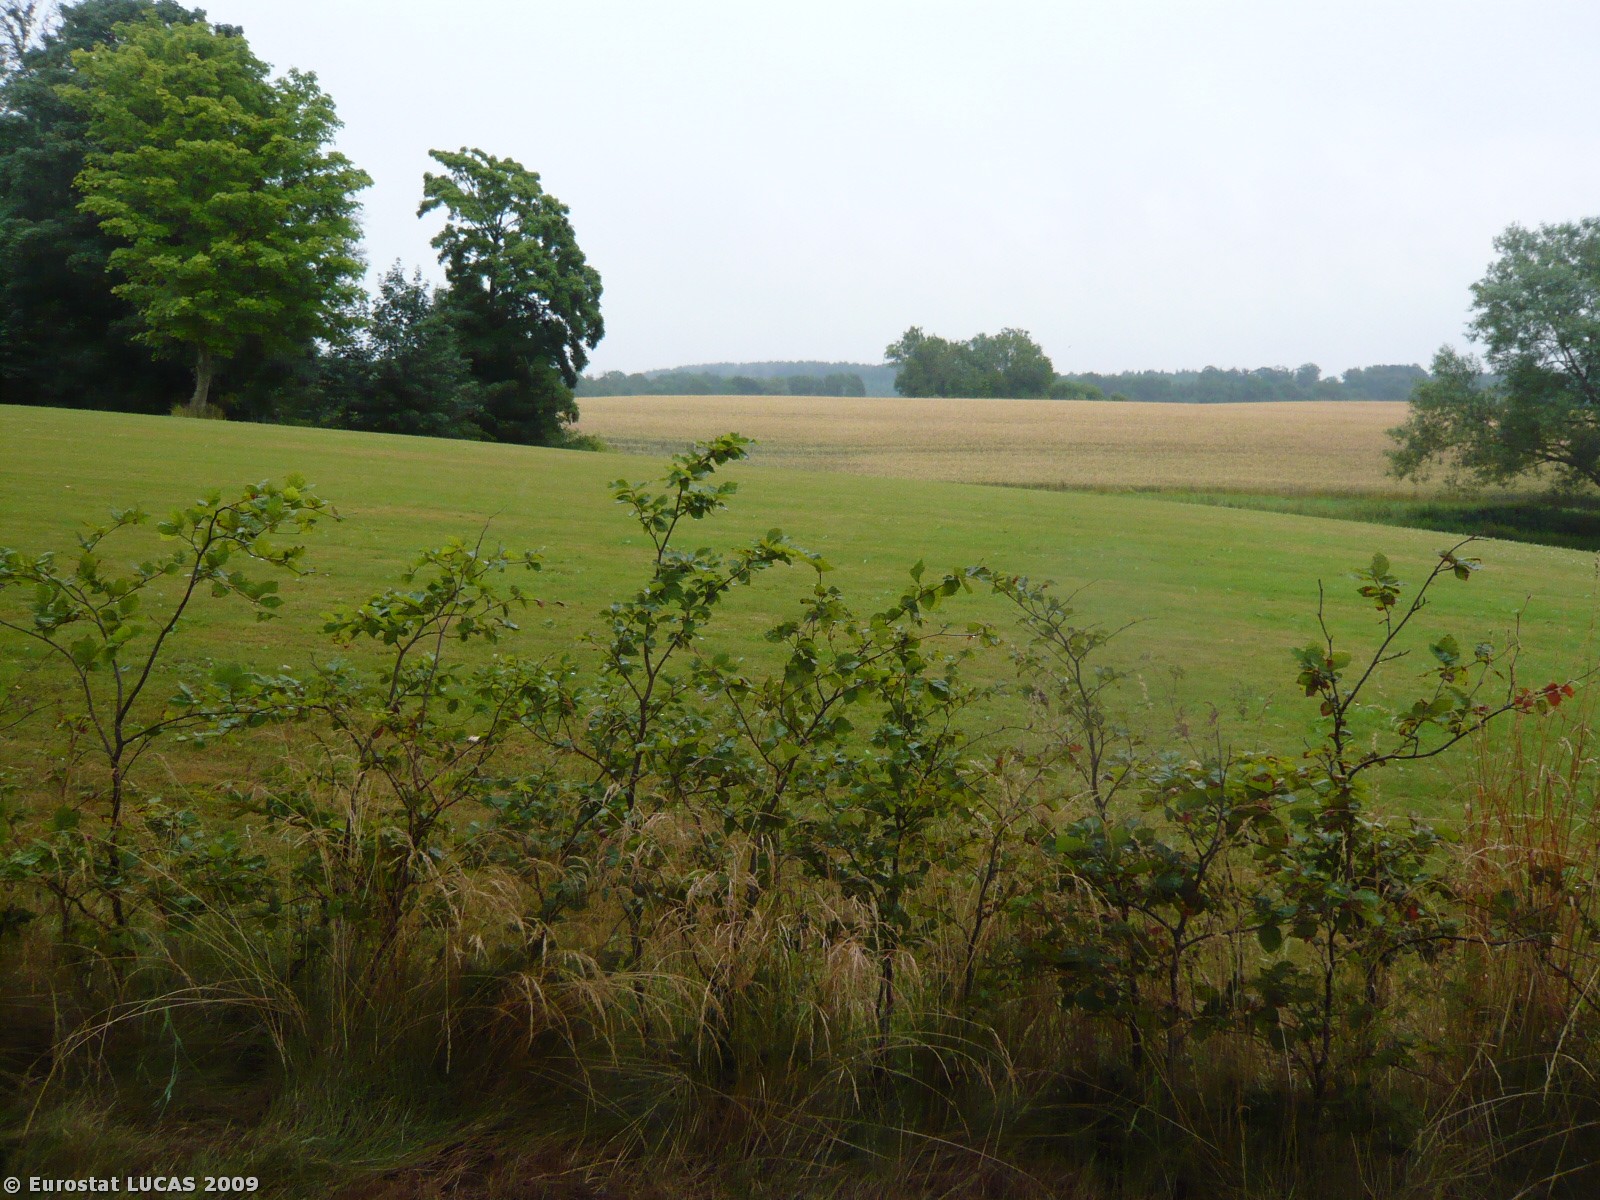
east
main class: Cropland
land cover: Common wheat
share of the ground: > 75 %
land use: Agriculture (excluding fallow land and kitchen gardens)
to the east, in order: Common wheat
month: July
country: DK
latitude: 55.6016
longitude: 11.6650
